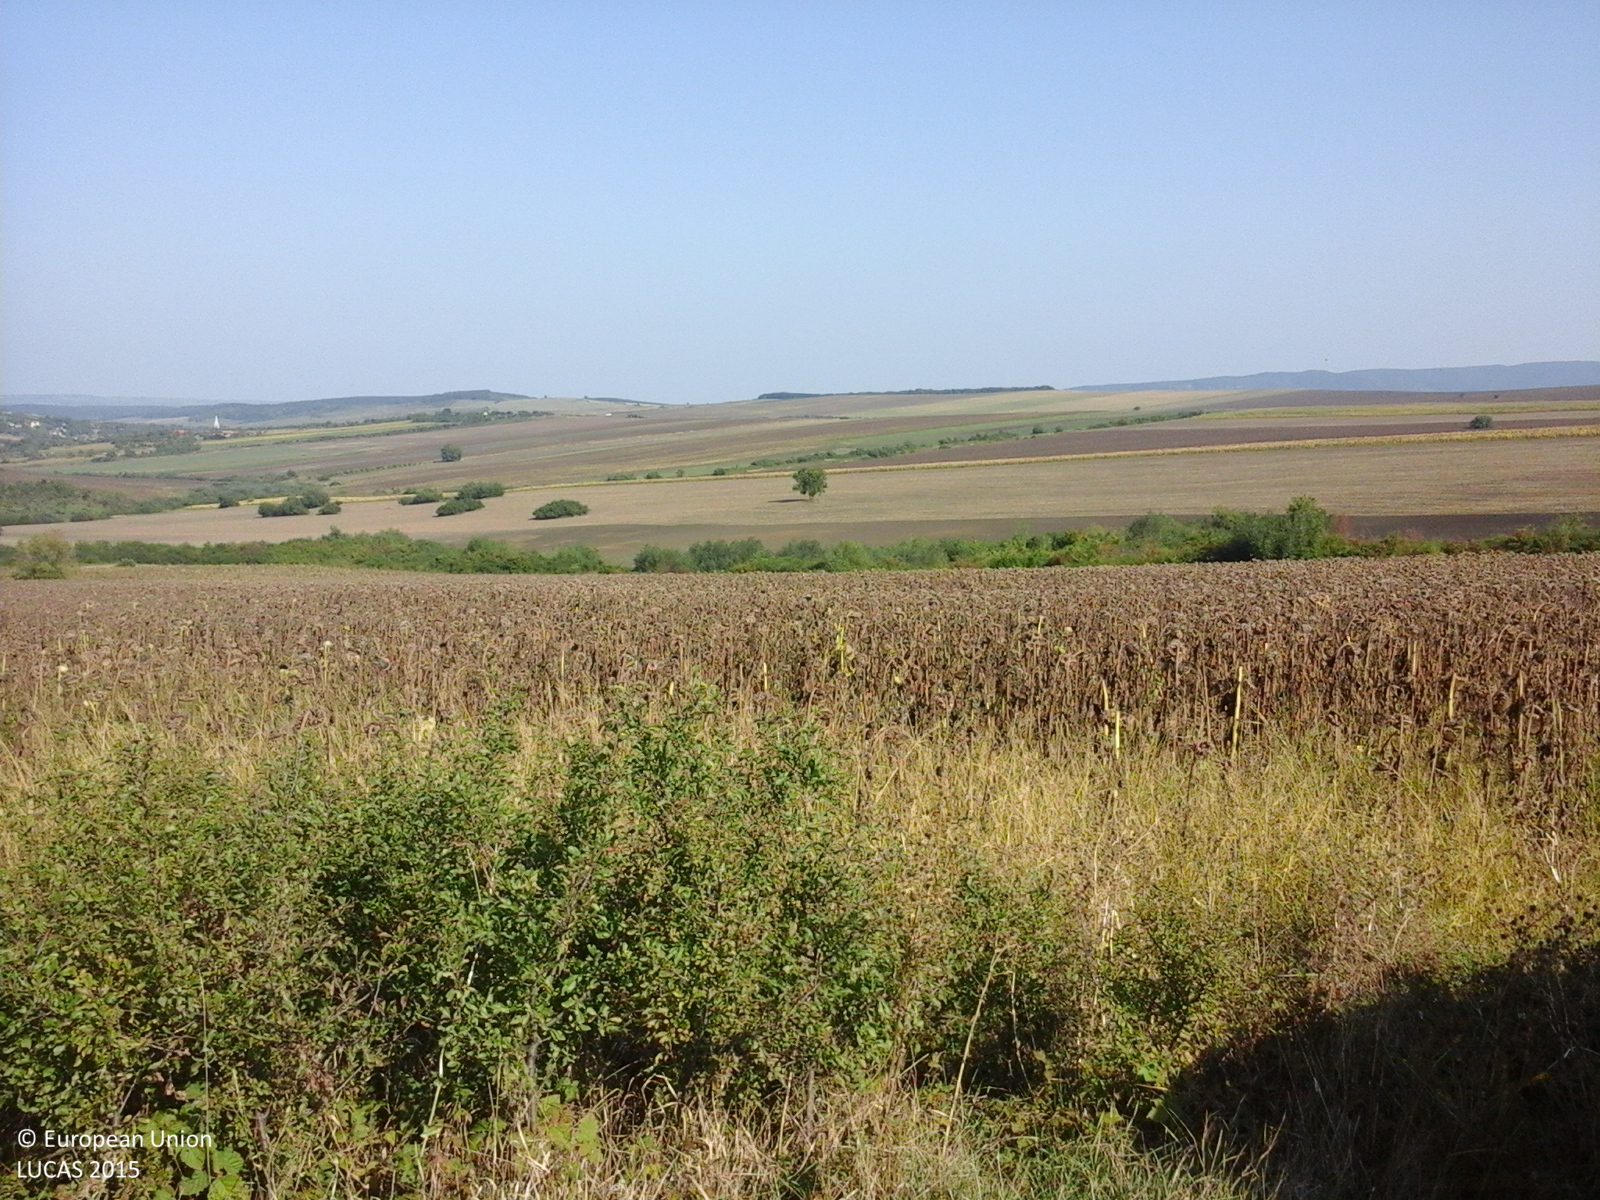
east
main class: Grassland
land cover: Spontaneously vegetated surfaces
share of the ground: 10 - 25 %
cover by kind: herbaceous plants 100 %
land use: Fallow land
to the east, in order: Spontaneously vegetated surfaces; Grass margins; Maize; Grass margins; Fences; Grass margins; Tracks; Grass margins; Abandoned hedges; Spontaneously vegetated surfaces; Sunflower
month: September
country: RO
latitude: 47.2899
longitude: 22.6596
